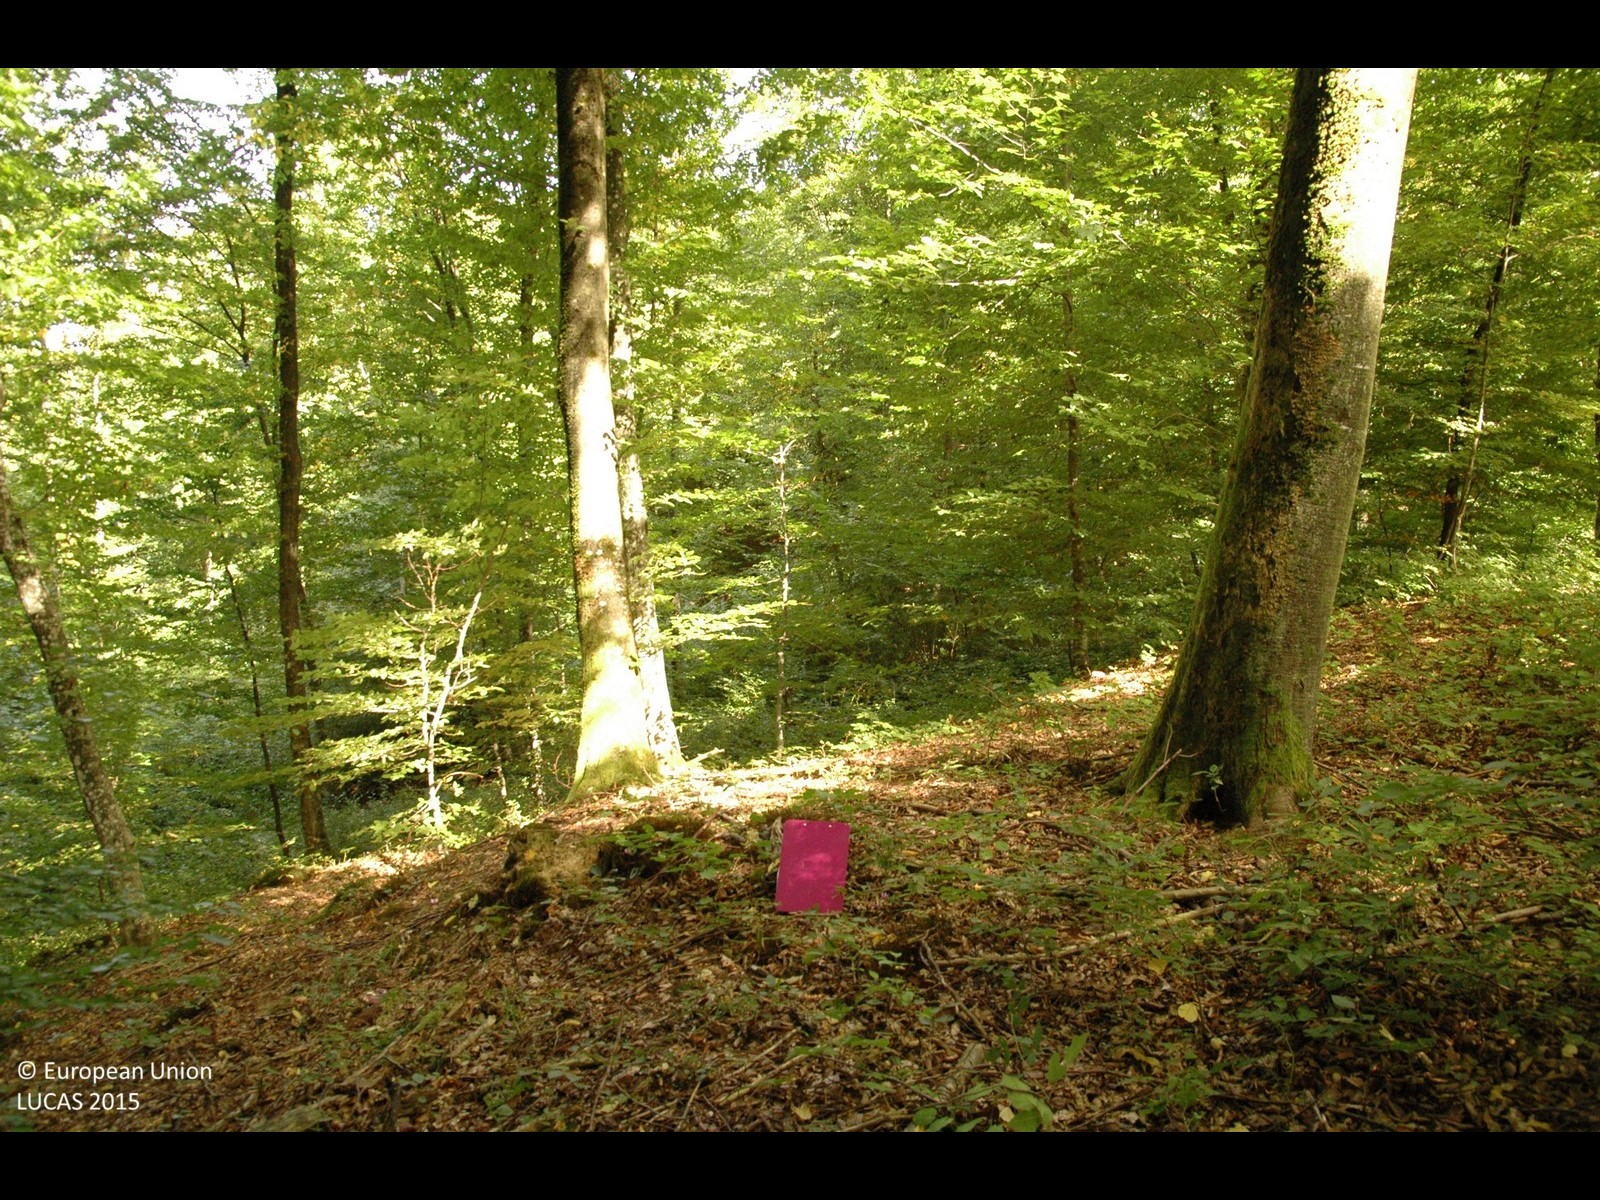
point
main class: Woodland
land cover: Broadleaved woodland
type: mesophytic deciduous forest
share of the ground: > 75 %
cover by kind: broadleaved forest trees 100 %
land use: Forestry
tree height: > 5 m
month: September
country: HR
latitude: 45.5740
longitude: 15.9045
